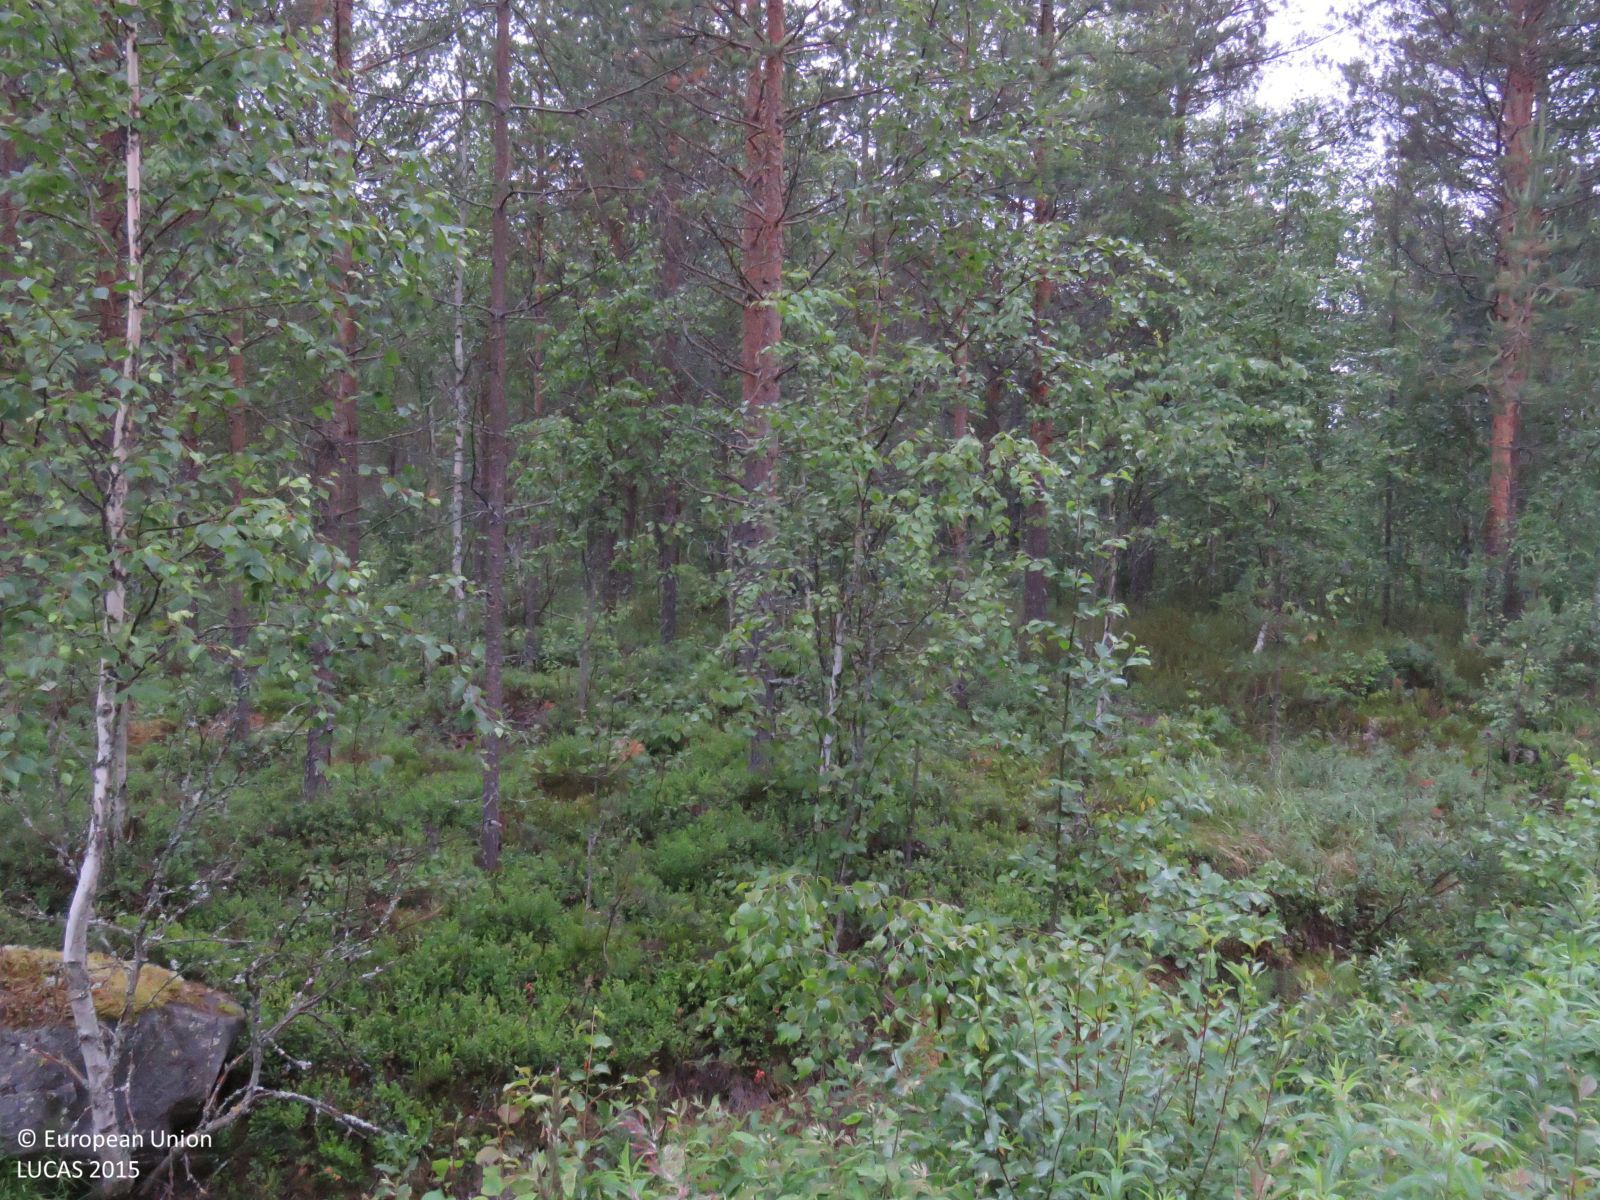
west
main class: Woodland
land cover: Pine dominated mixed woodland
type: boreal forest
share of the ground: > 75 %
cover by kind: coniferous forest trees 55 %, broadleaved forest trees 20 %, shrubs 20 %, lichens and mosses 5 %
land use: Forestry
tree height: > 5 m
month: July
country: FI
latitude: 64.3163
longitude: 26.5589
